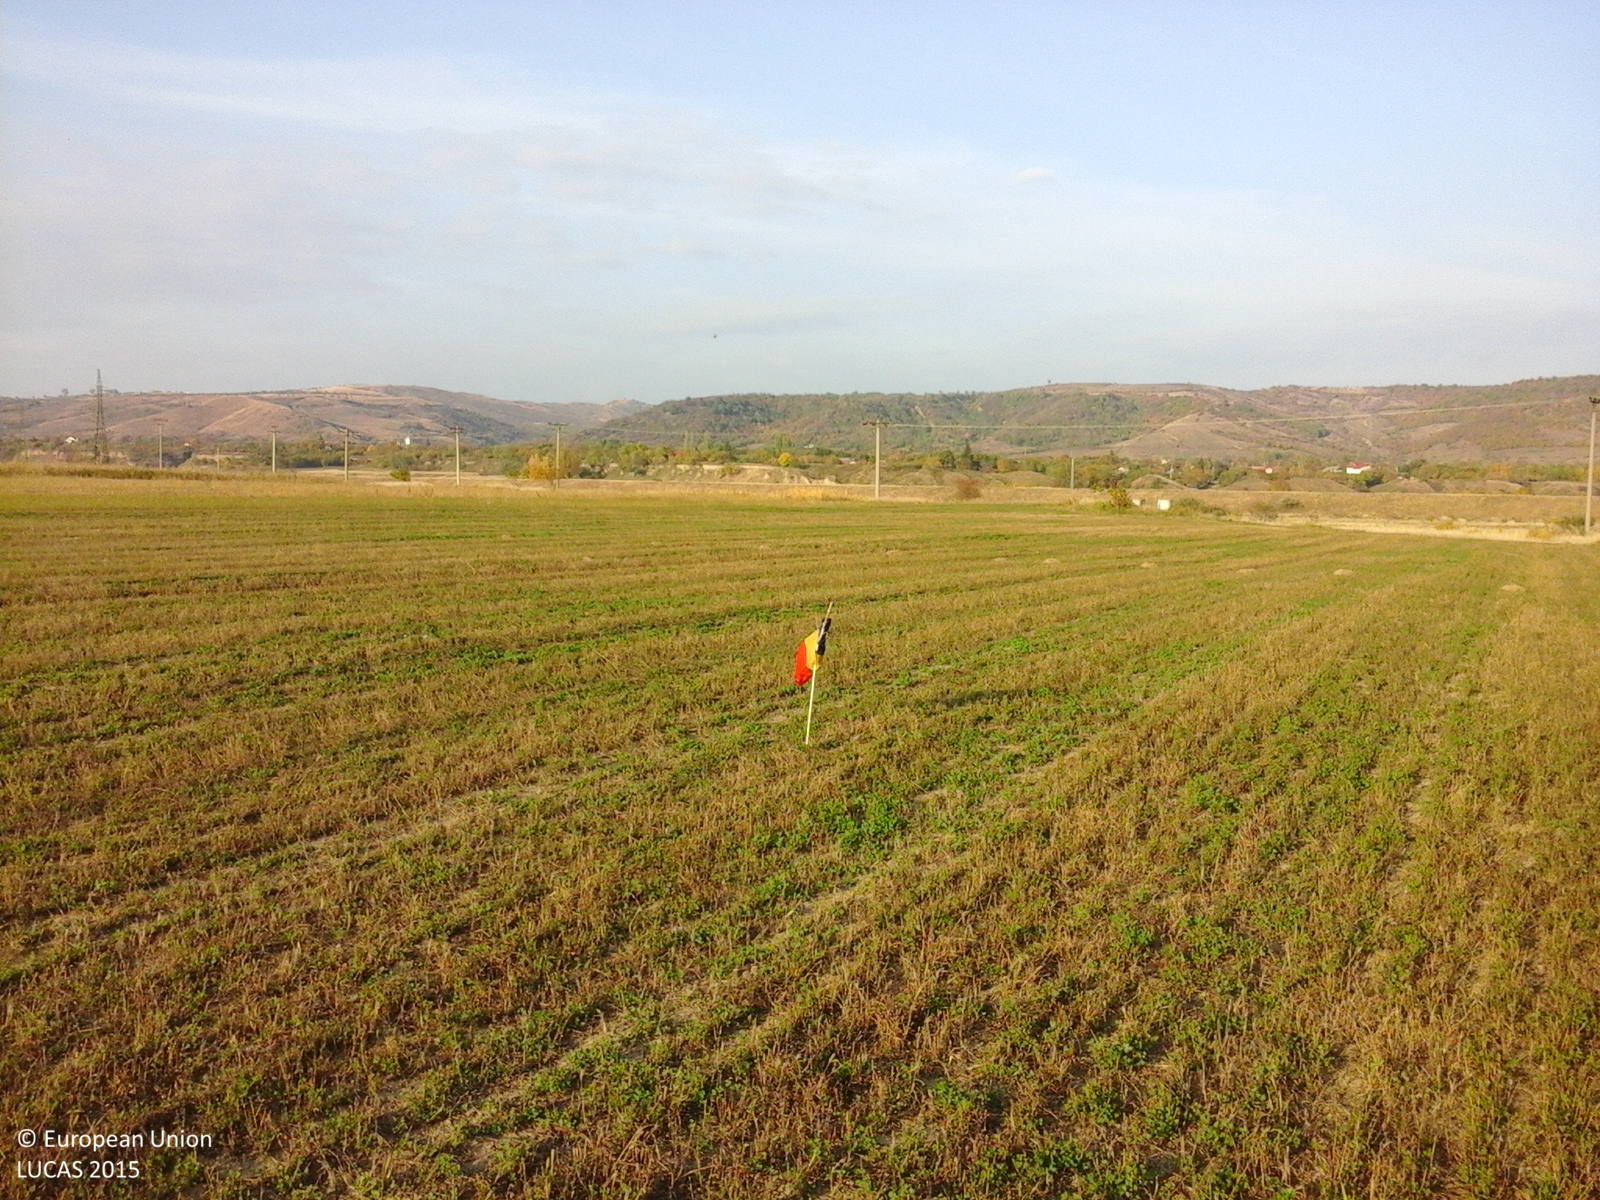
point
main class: Cropland
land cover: Lucerne
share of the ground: 50 - 75 %
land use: Agriculture (excluding fallow land and kitchen gardens)
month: October
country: RO
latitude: 45.2638
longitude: 26.7094
